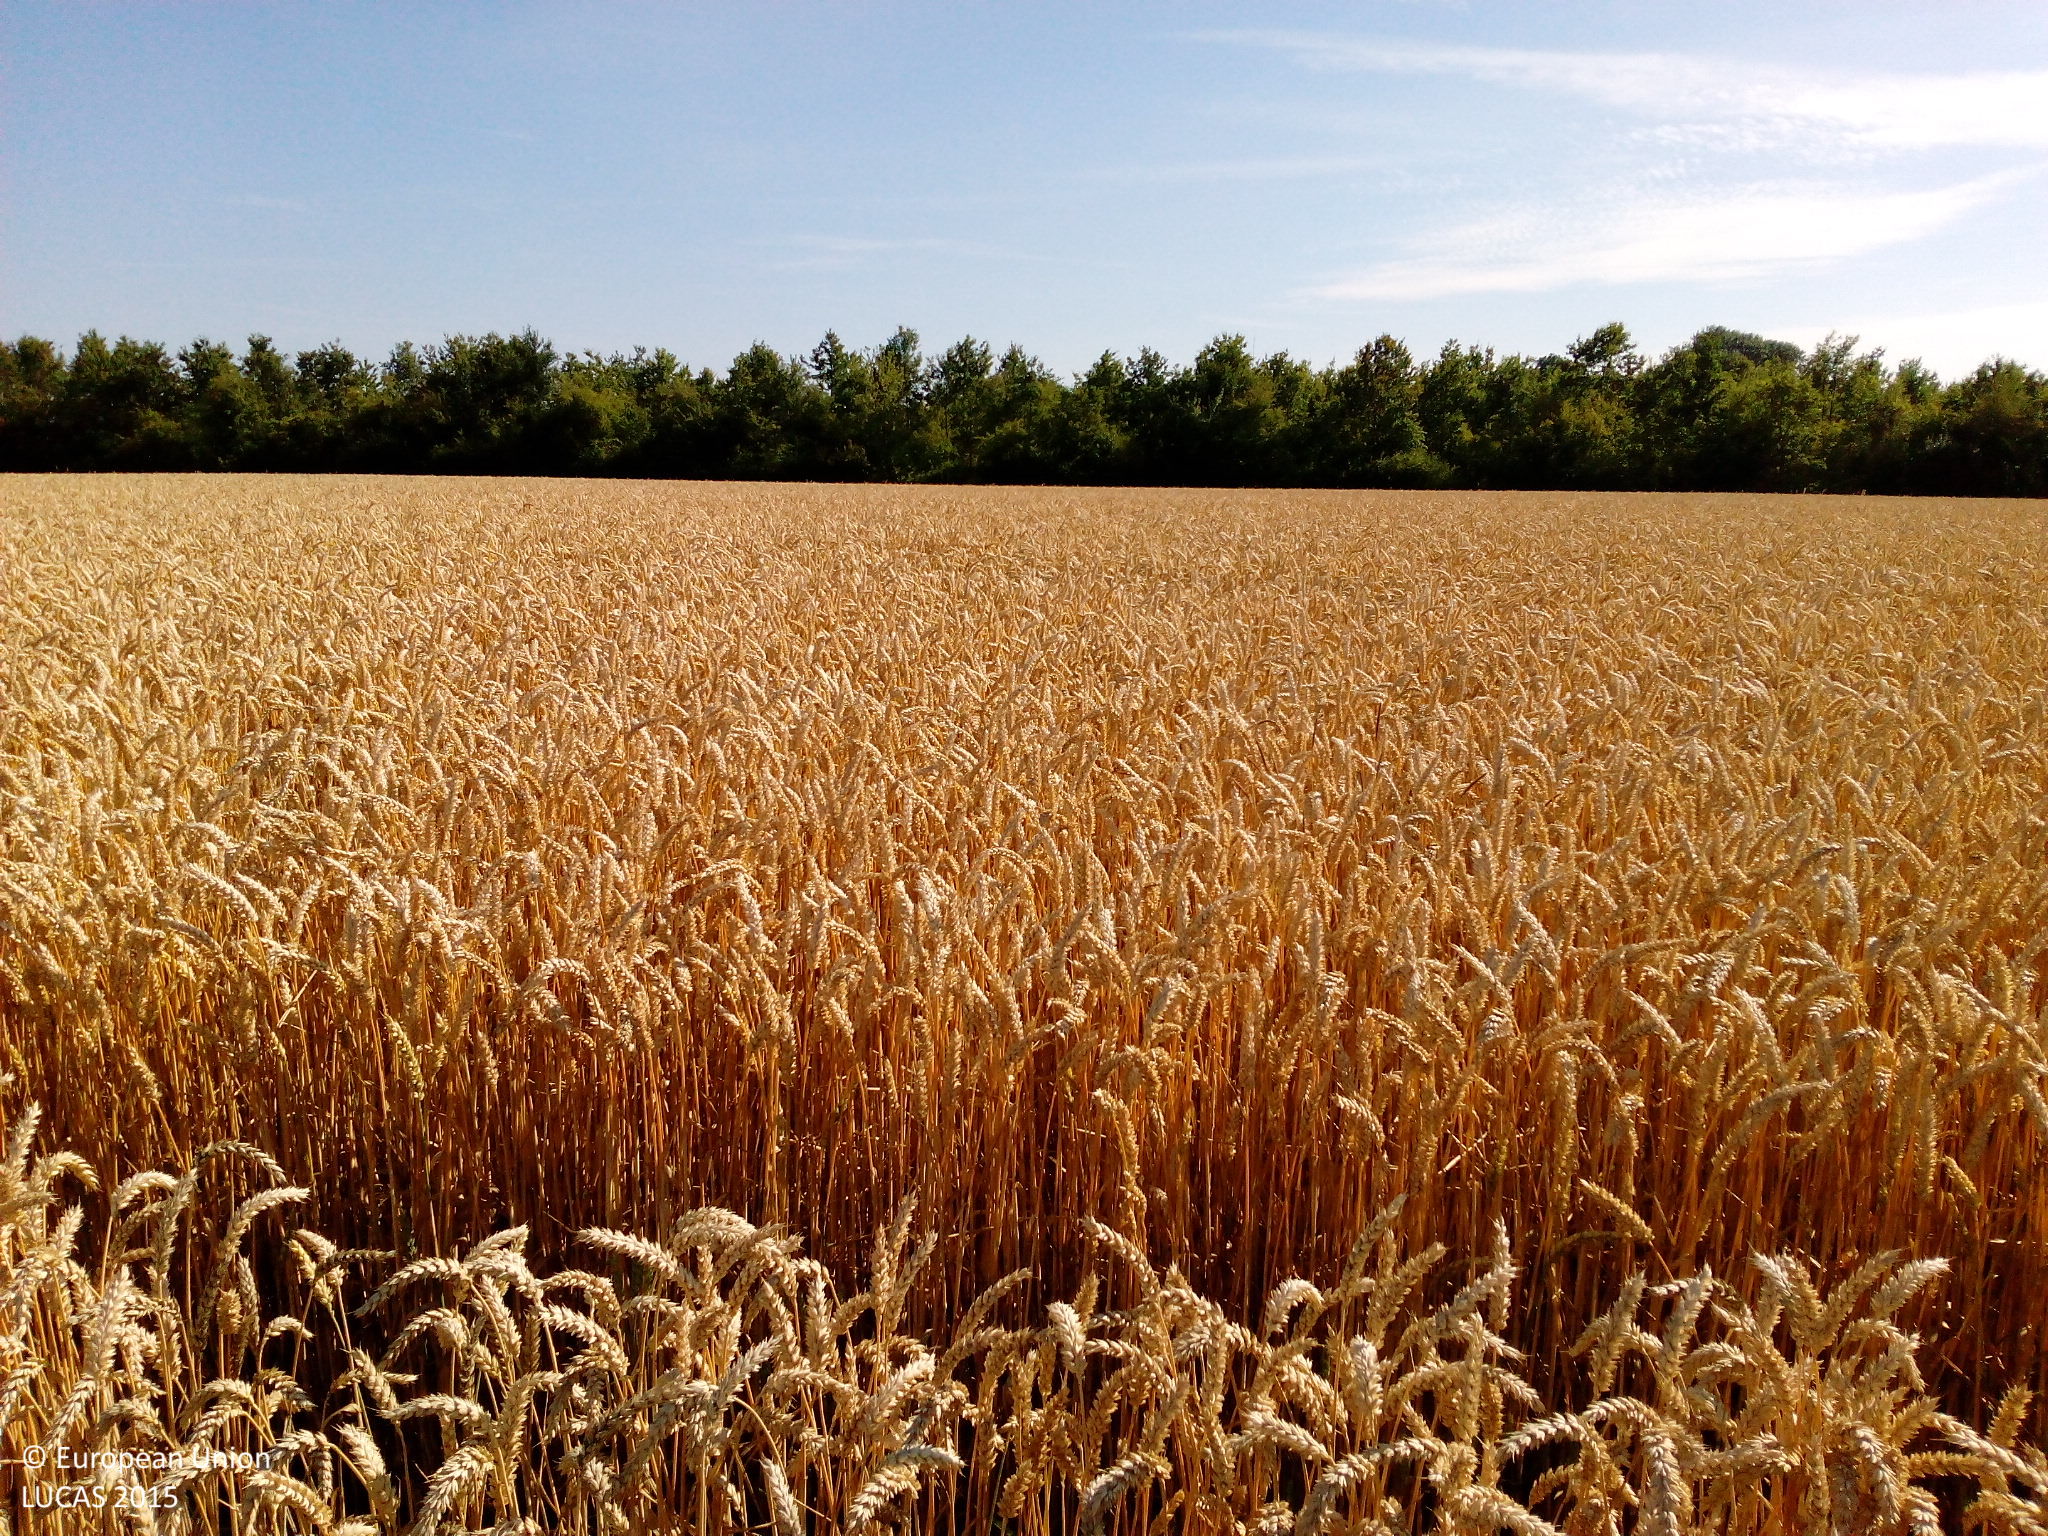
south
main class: Cropland
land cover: Common wheat
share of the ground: > 75 %
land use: Agriculture (excluding fallow land and kitchen gardens)
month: August
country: DK
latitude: 55.4023
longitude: 11.7830
